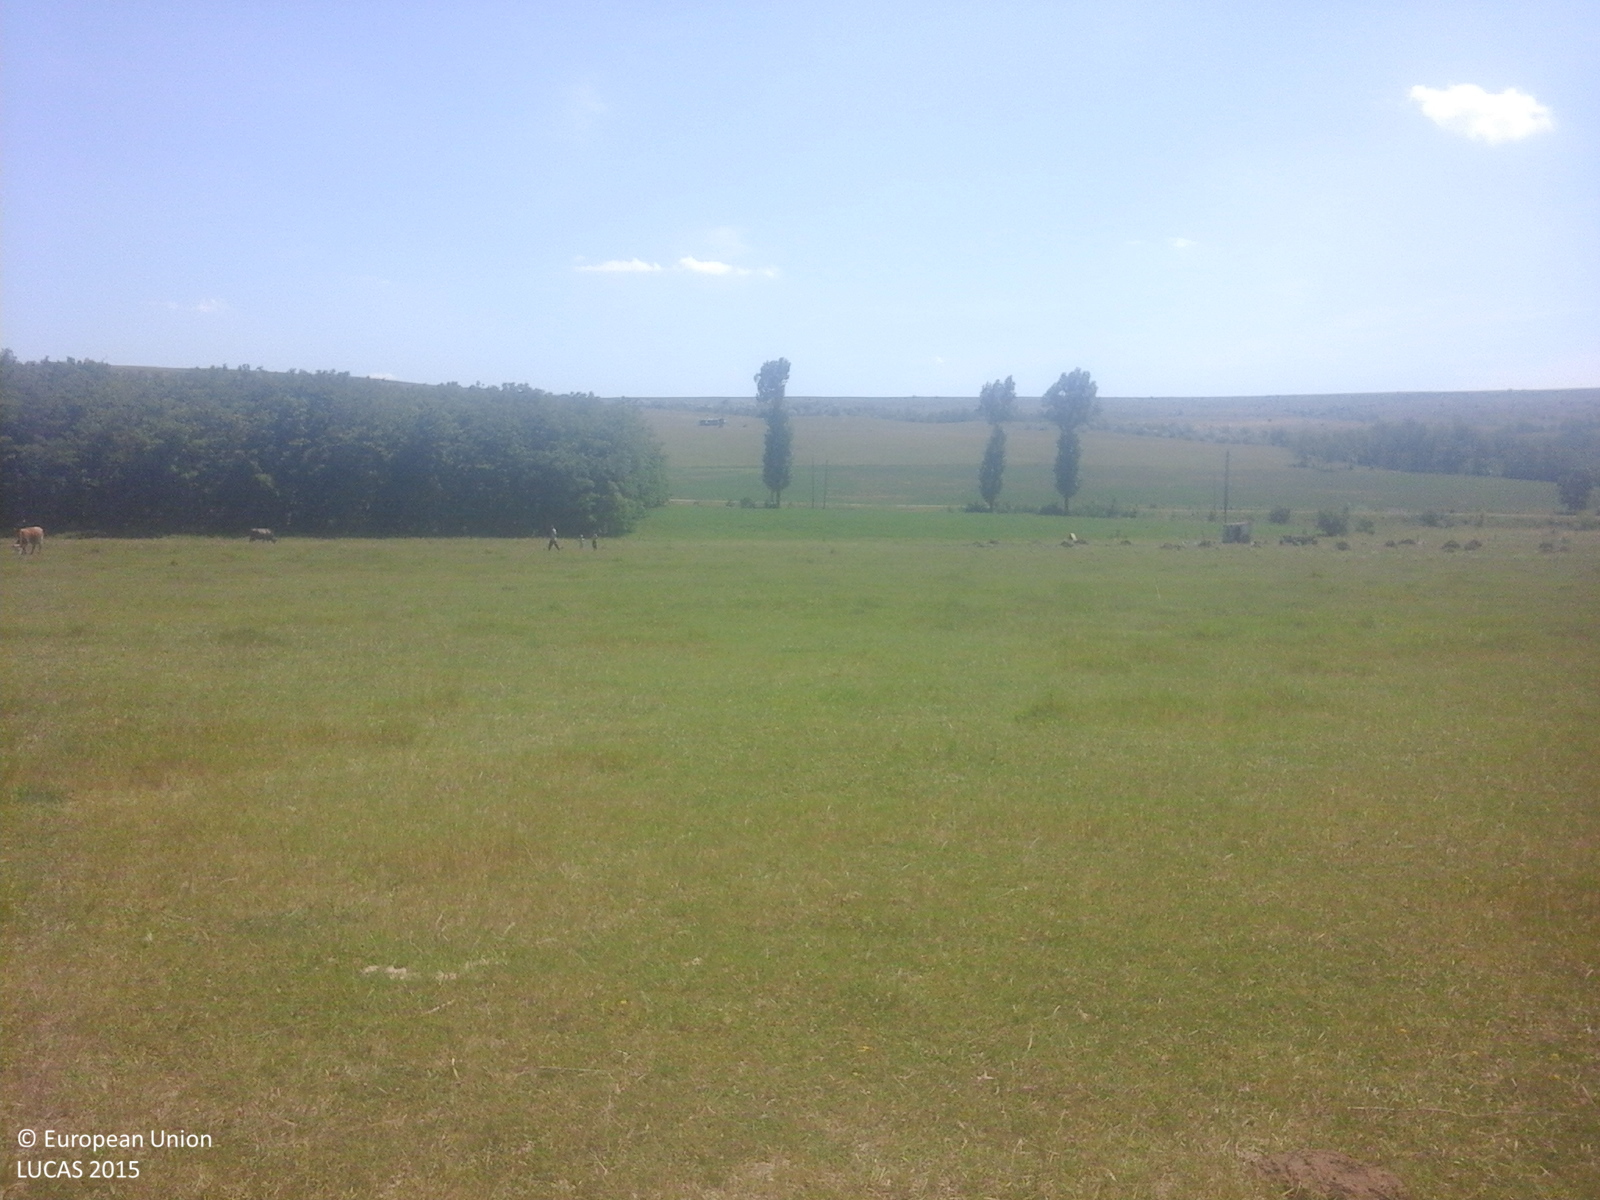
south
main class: Grassland
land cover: Grassland without tree/shrub cover
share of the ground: > 75 %
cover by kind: herbaceous plants 100 %
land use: Agriculture (excluding fallow land and kitchen gardens)
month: June
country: RO
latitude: 47.9310
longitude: 26.9286
